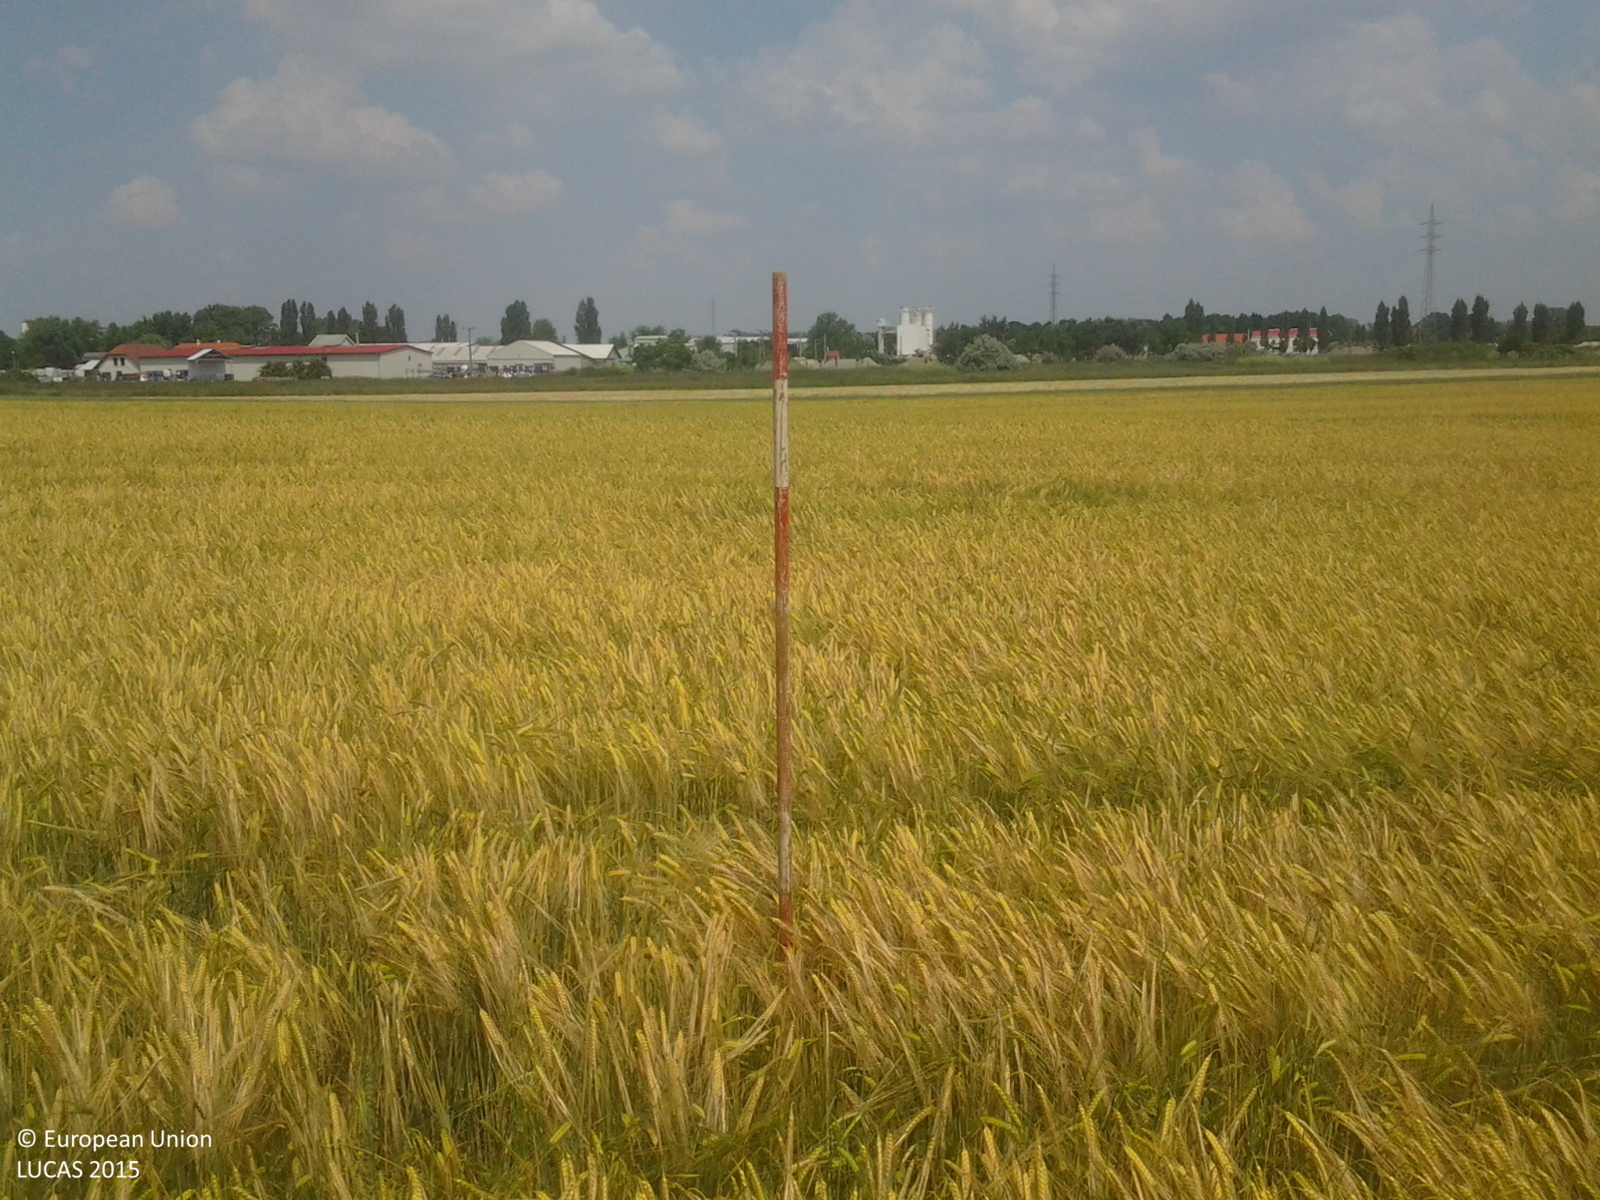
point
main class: Cropland
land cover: Barley
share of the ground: > 75 %
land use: Agriculture (excluding fallow land and kitchen gardens)
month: June
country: HU
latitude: 46.8868
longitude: 19.7192
